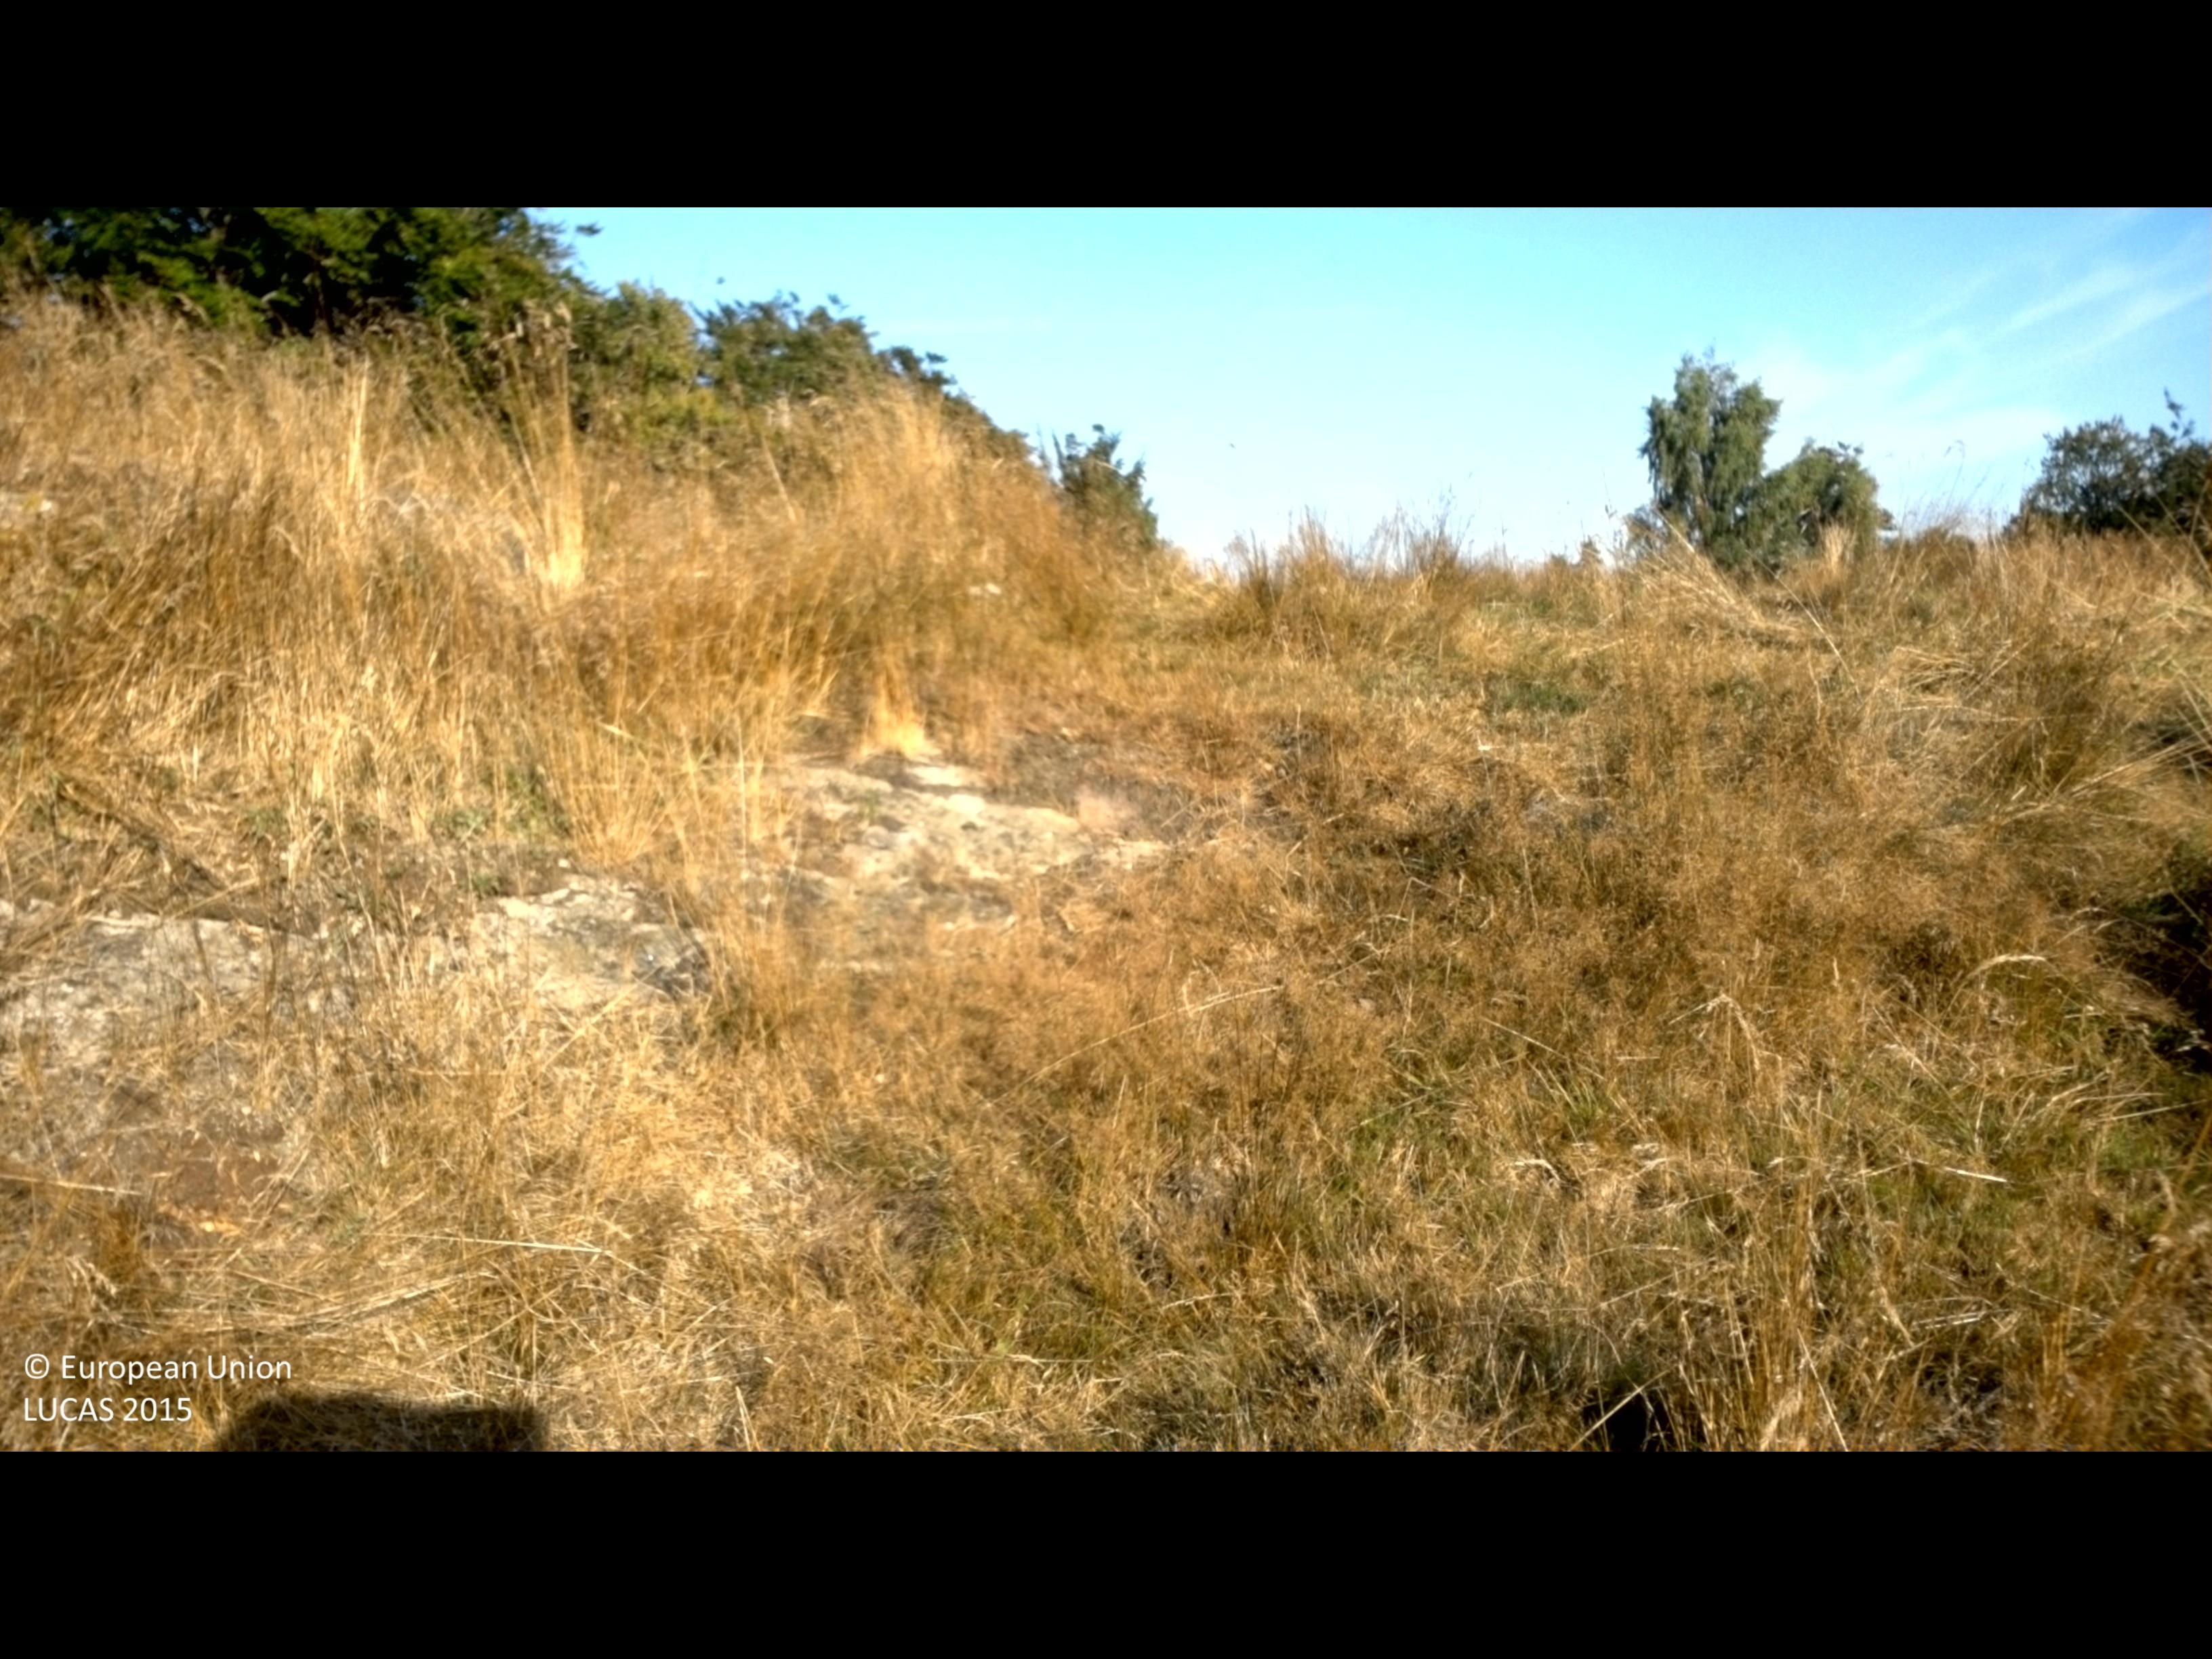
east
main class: Grassland
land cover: Grassland without tree/shrub cover
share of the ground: > 75 %
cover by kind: herbaceous plants 90 %, consolidated bare surface 10 %
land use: Agriculture (excluding fallow land and kitchen gardens)
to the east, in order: Grassland without tree/shrub cover; Dry stone walls; Broadleaved woodland; Fences; Broadleaved woodland; Fences; Grassland without tree/shrub cover; Fences; Grassland with sparse tree/shrub cover; Fences; Grassland with sparse tree/shrub cover; Fences; Broadleaved woodland
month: August
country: SE
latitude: 56.1992
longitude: 14.4948
